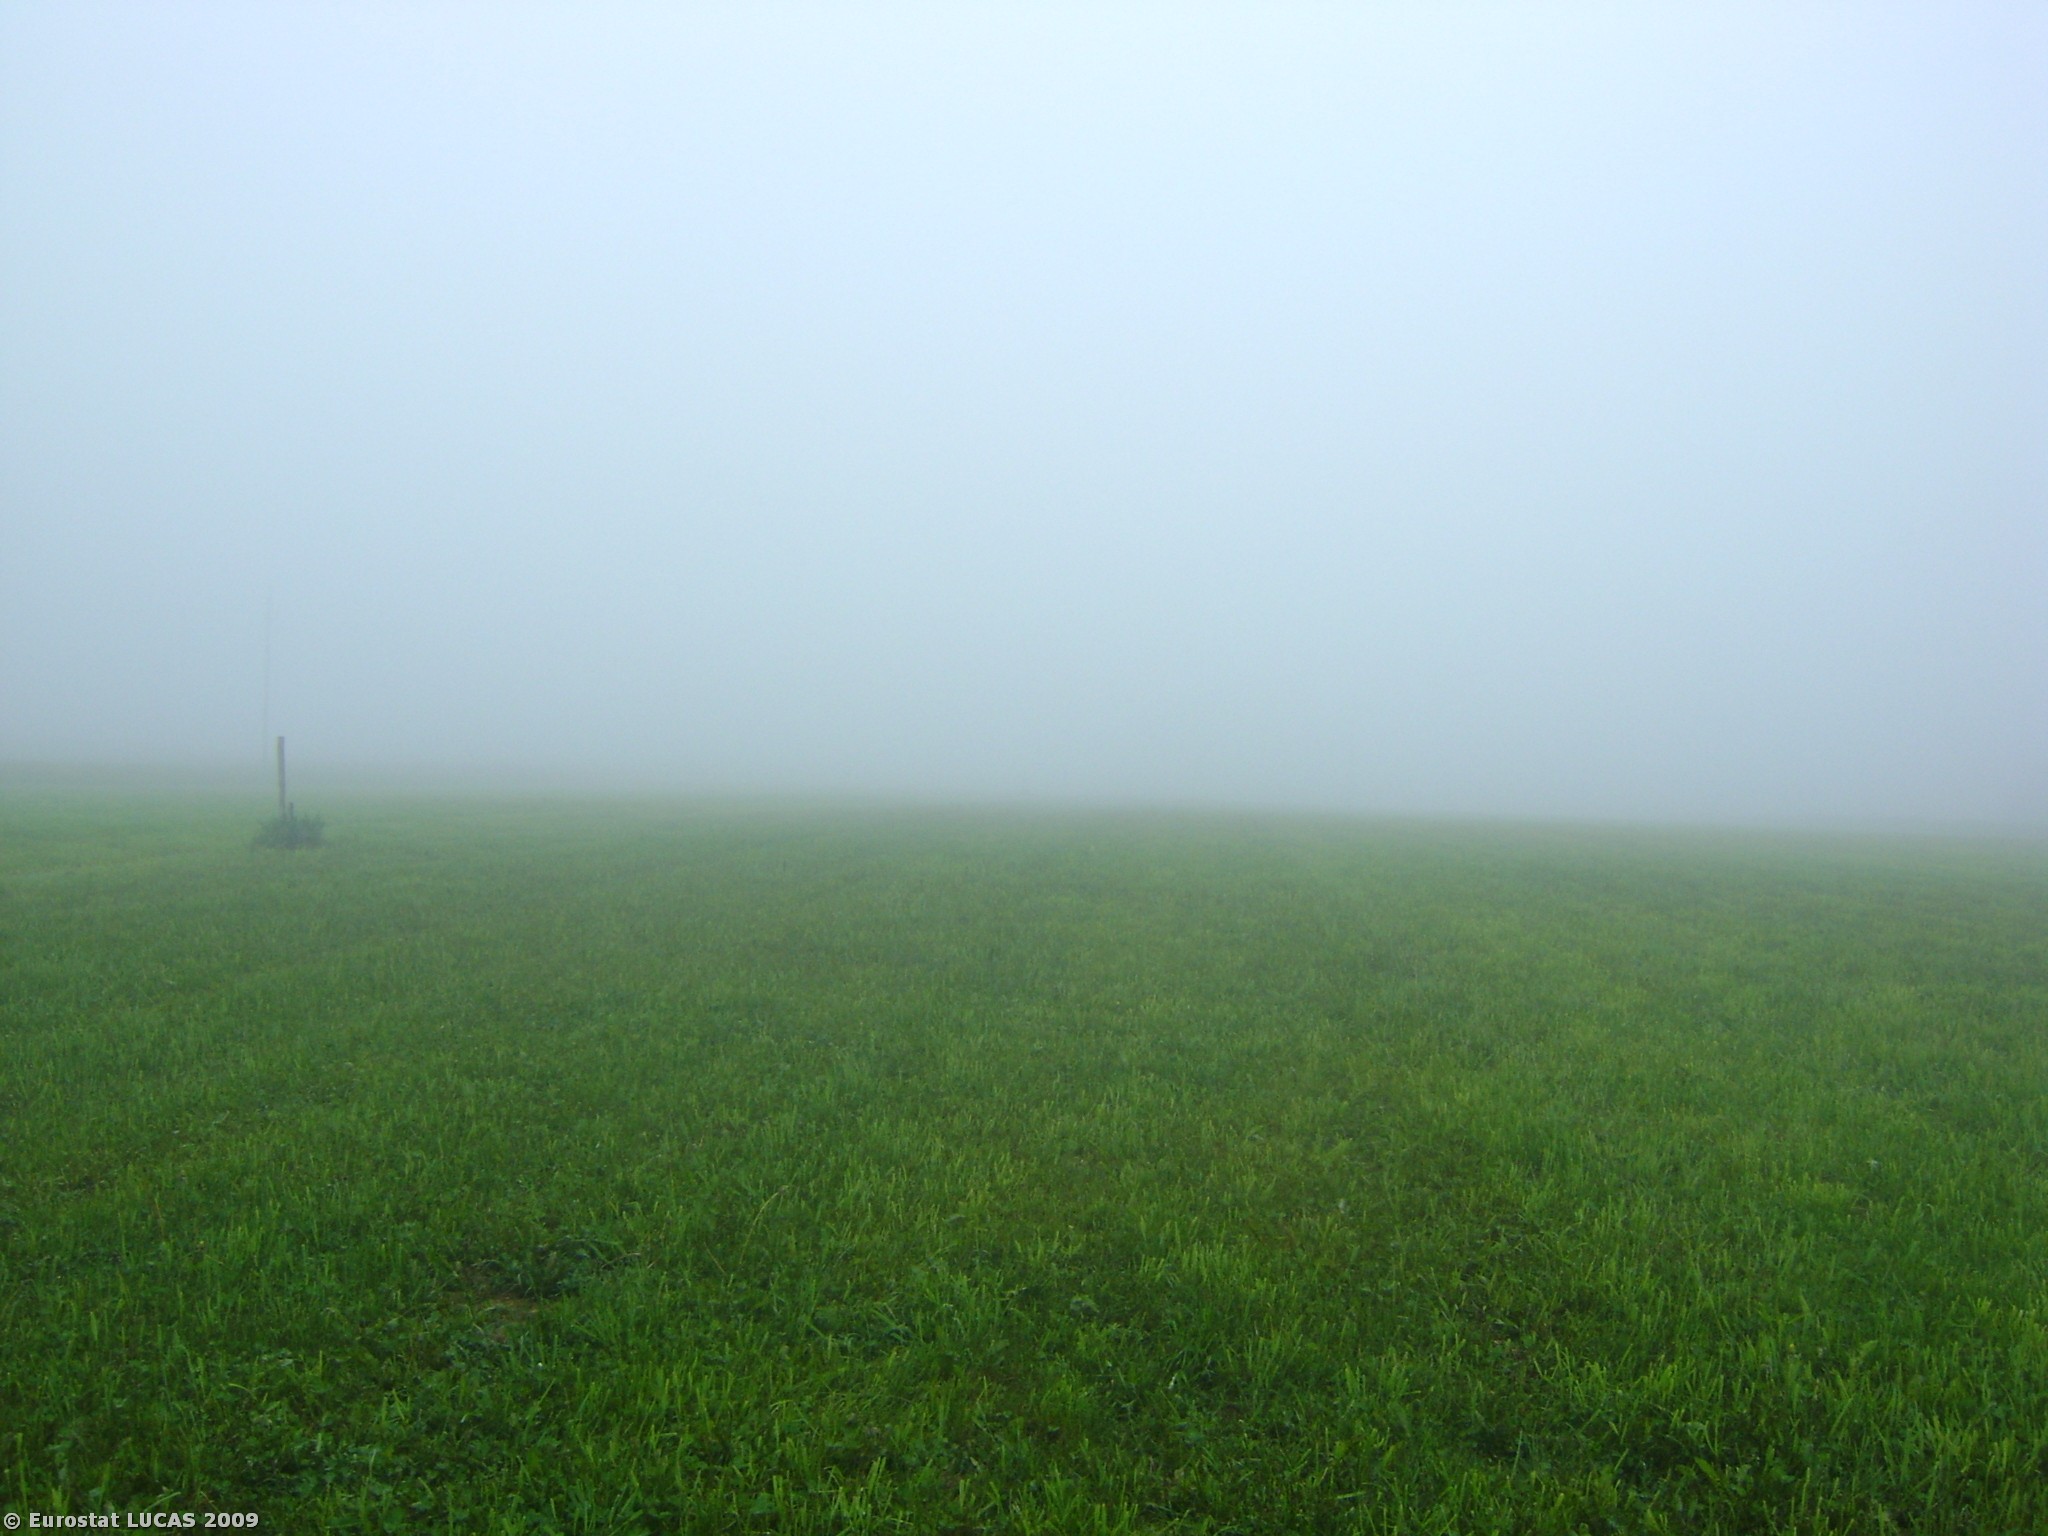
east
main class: Grassland
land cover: Grassland without tree/shrub cover
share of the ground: > 75 %
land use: Agriculture (excluding fallow land and kitchen gardens)
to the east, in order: Grassland without tree/shrub cover; Electric lines; Grassland without tree/shrub cover
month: May
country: AT
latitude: 47.9938
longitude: 13.3090
